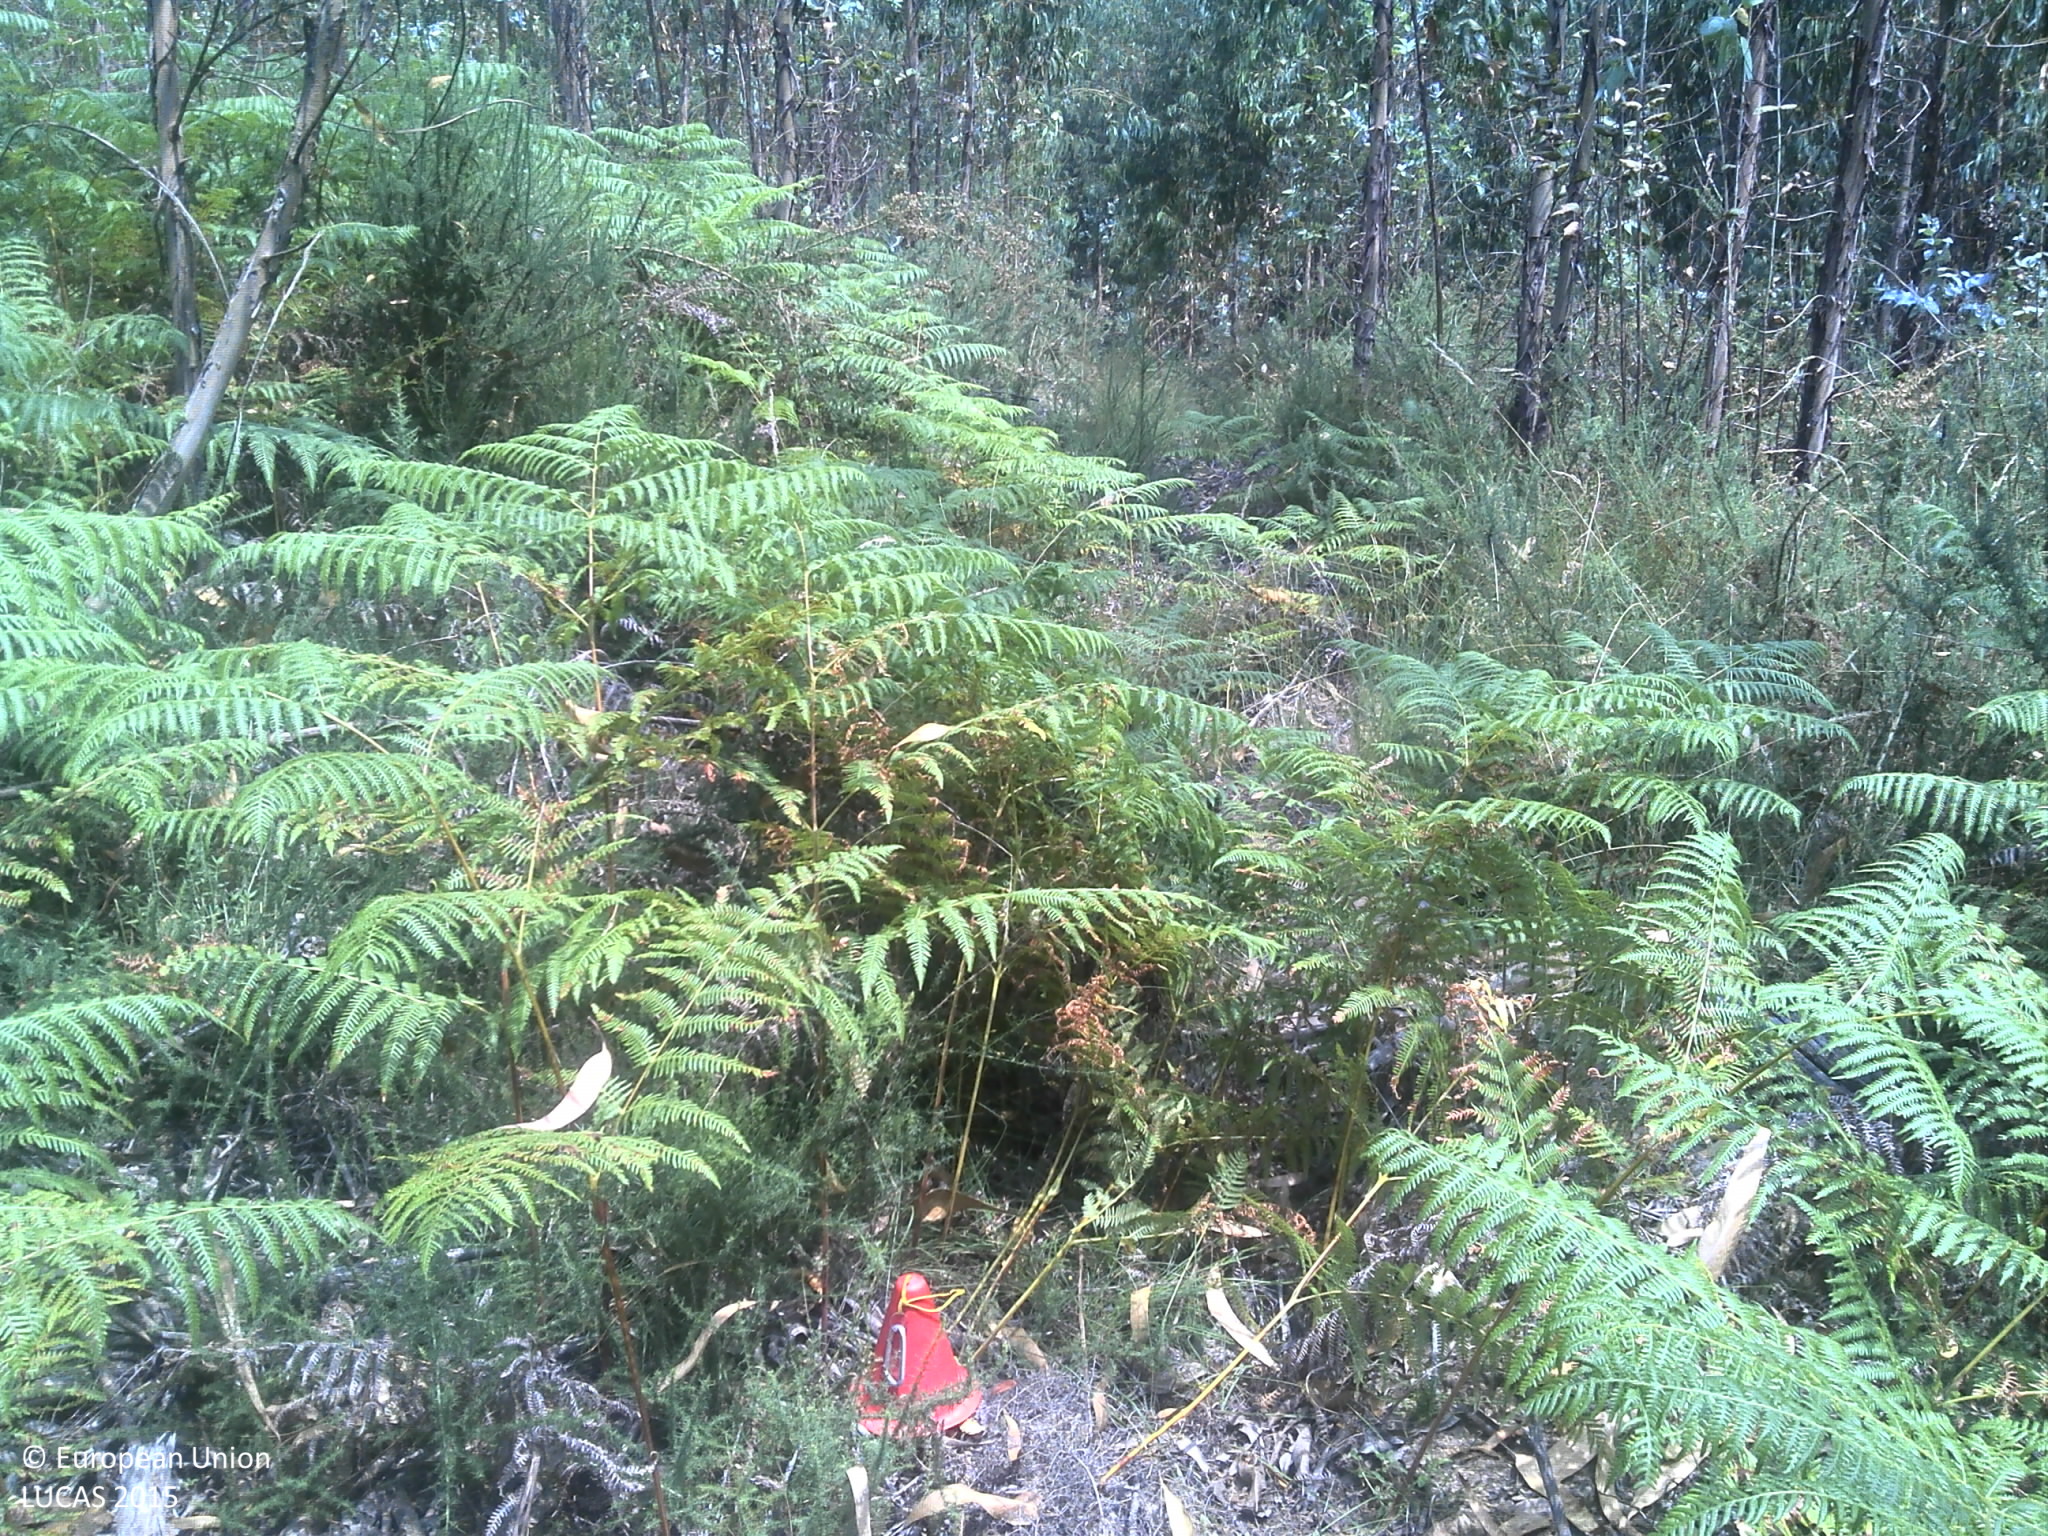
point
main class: Woodland
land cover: Broadleaved woodland
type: exotic forest
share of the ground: 50 - 75 %
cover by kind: broadleaved forest trees 60 %, shrubs 35 %, unconsolidated bare surface 5 %
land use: Forestry
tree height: > 5 m
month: June
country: PT
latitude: 41.3089
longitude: -8.2649
